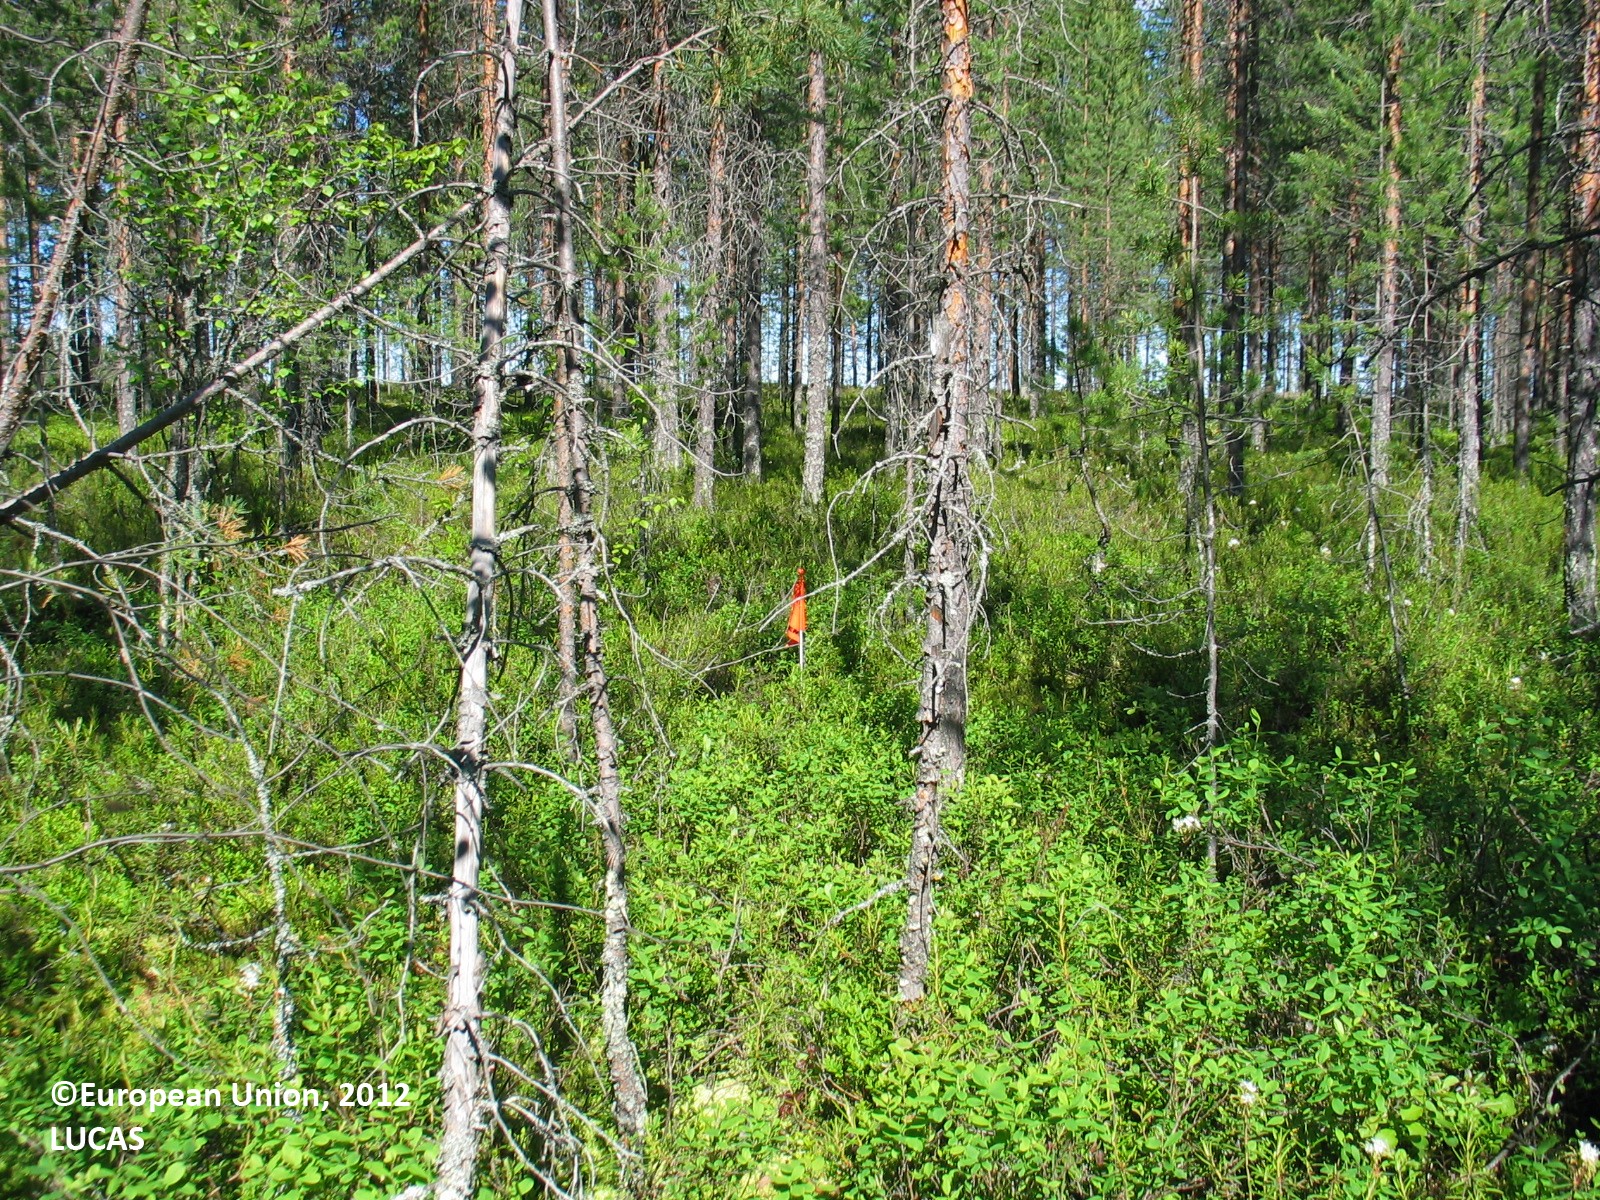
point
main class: Woodland
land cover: Pine dominated coniferous woodland
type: mire and swamp forests
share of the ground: 25 - 50 %
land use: Forestry
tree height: > 5 m
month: July
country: FI
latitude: 64.6997
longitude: 26.6199
